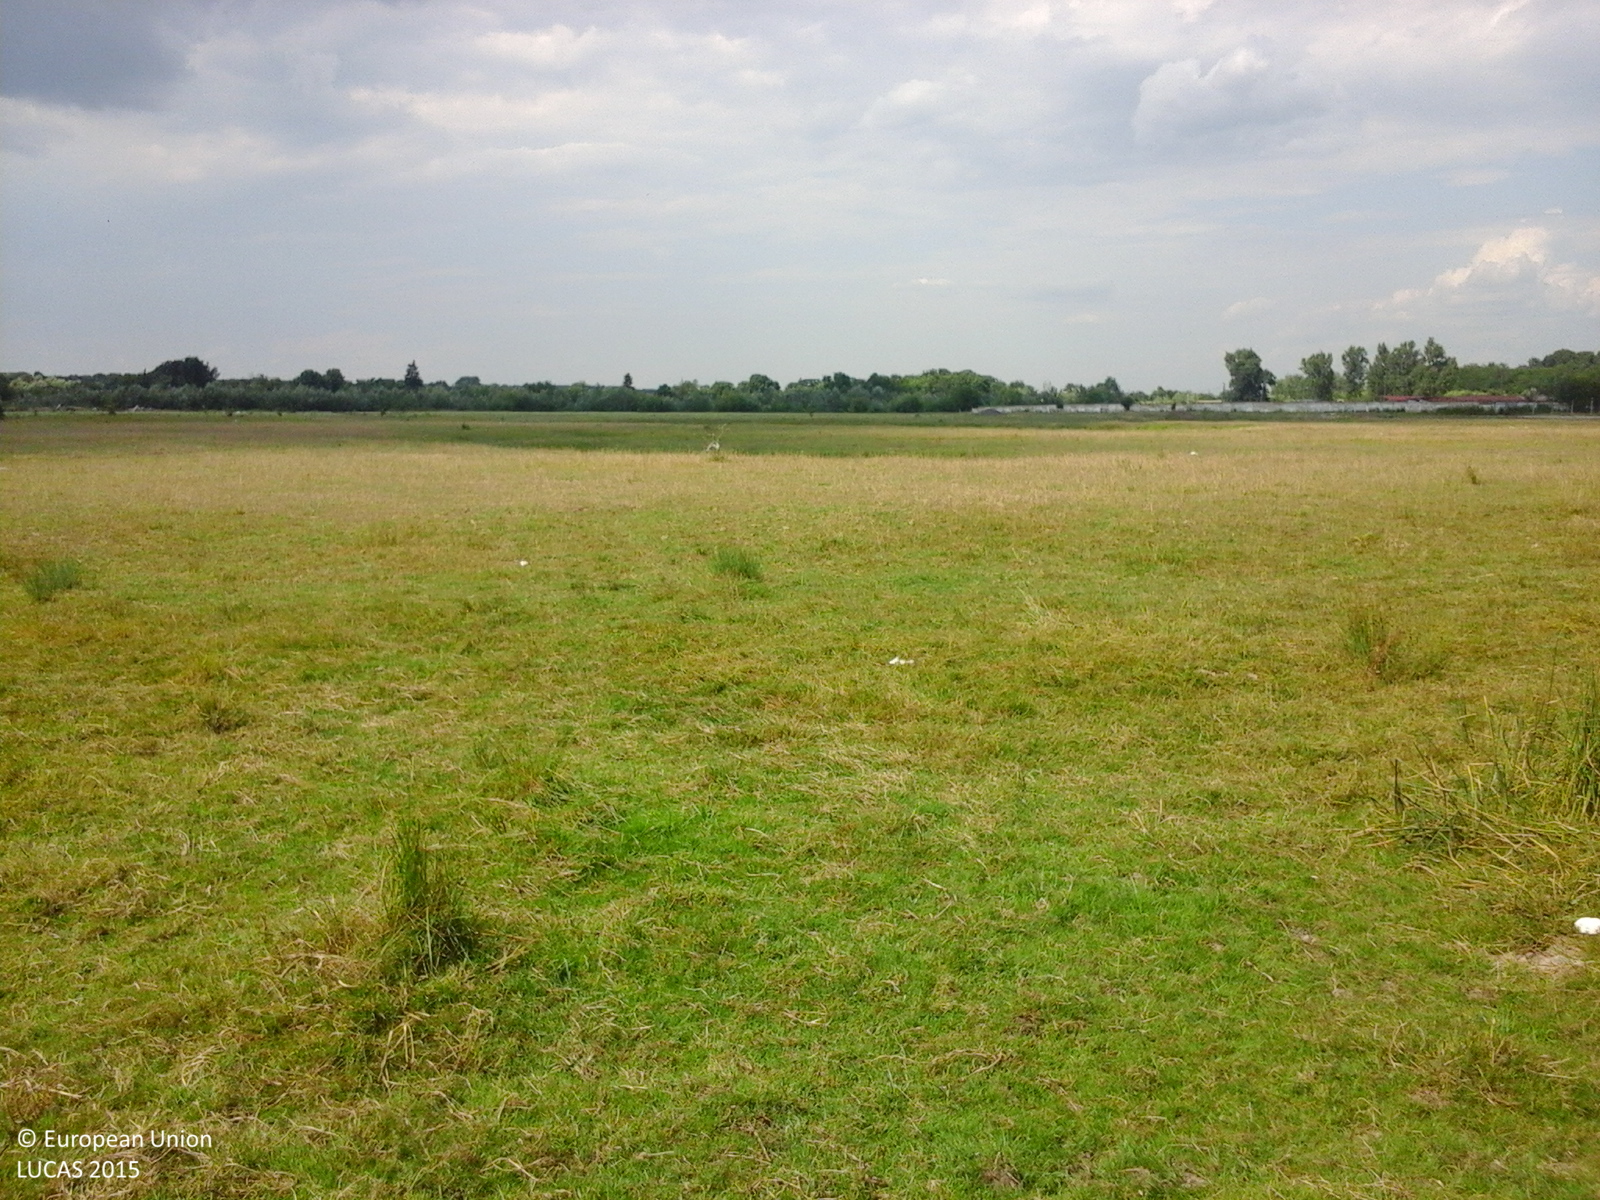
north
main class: Grassland
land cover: Grassland without tree/shrub cover
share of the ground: > 75 %
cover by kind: herbaceous plants 100 %
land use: Agriculture (excluding fallow land and kitchen gardens)
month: June
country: RO
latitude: 44.1650
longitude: 25.9944
